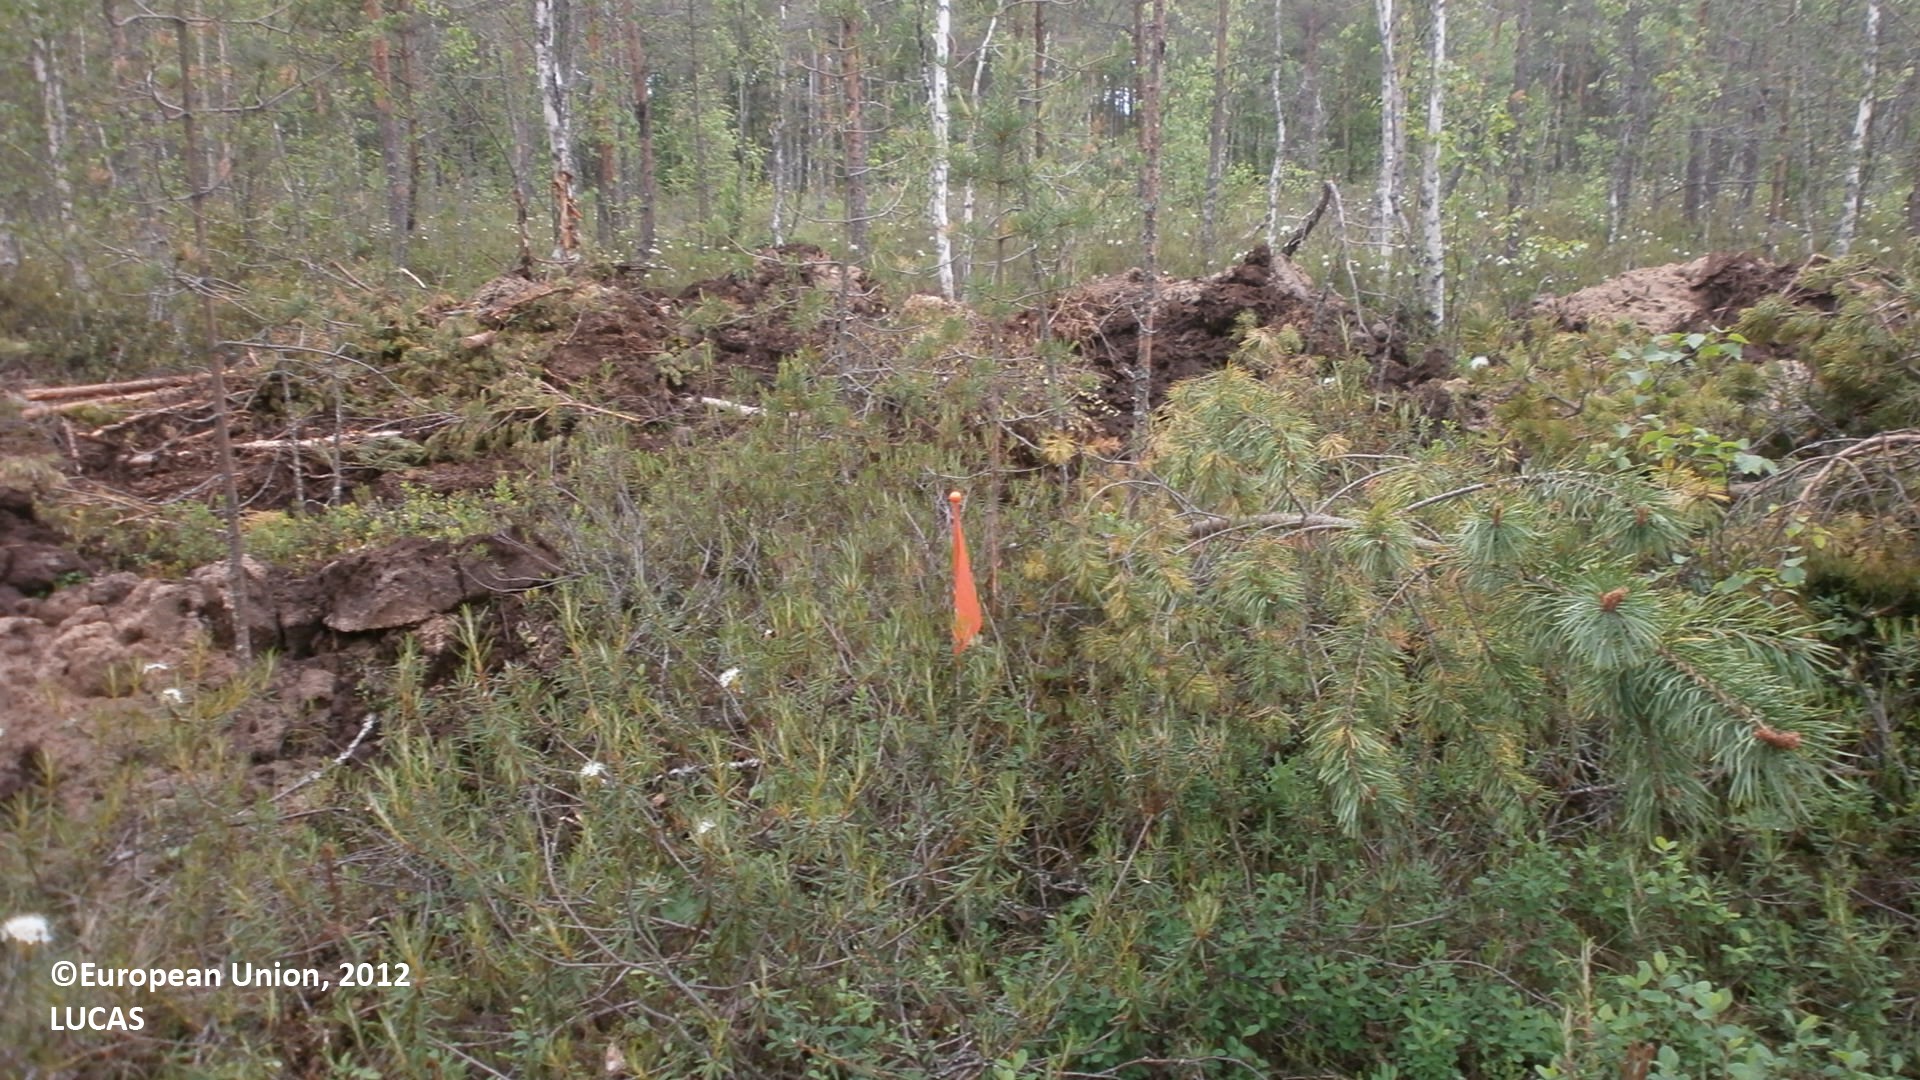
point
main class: Woodland
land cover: Pine dominated coniferous woodland
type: mire and swamp forests
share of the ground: 50 - 75 %
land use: Forestry
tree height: > 5 m
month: June
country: FI
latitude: 64.2830
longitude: 25.0576
